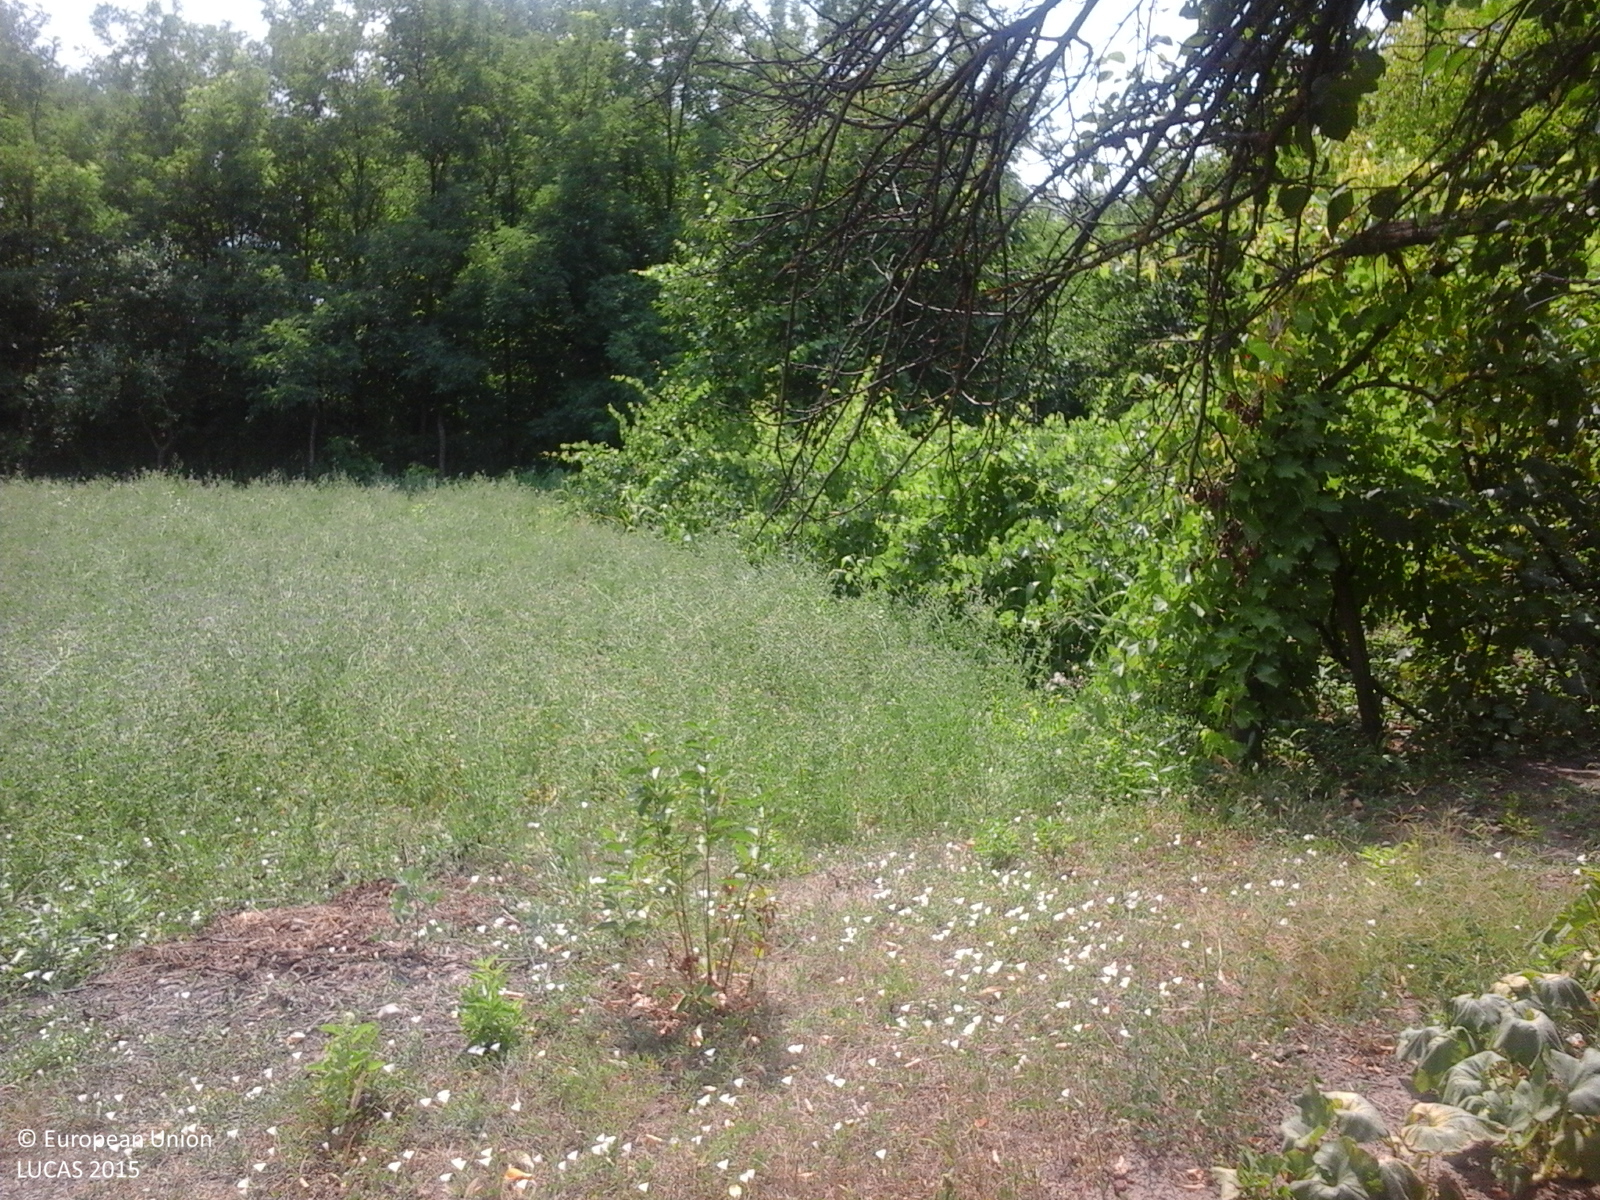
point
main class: Cropland
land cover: Vineyards
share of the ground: > 75 %
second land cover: Spontaneously vegetated surfaces
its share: > 75 %
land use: Kitchen garden
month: July
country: RO
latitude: 46.0004
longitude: 27.9262
